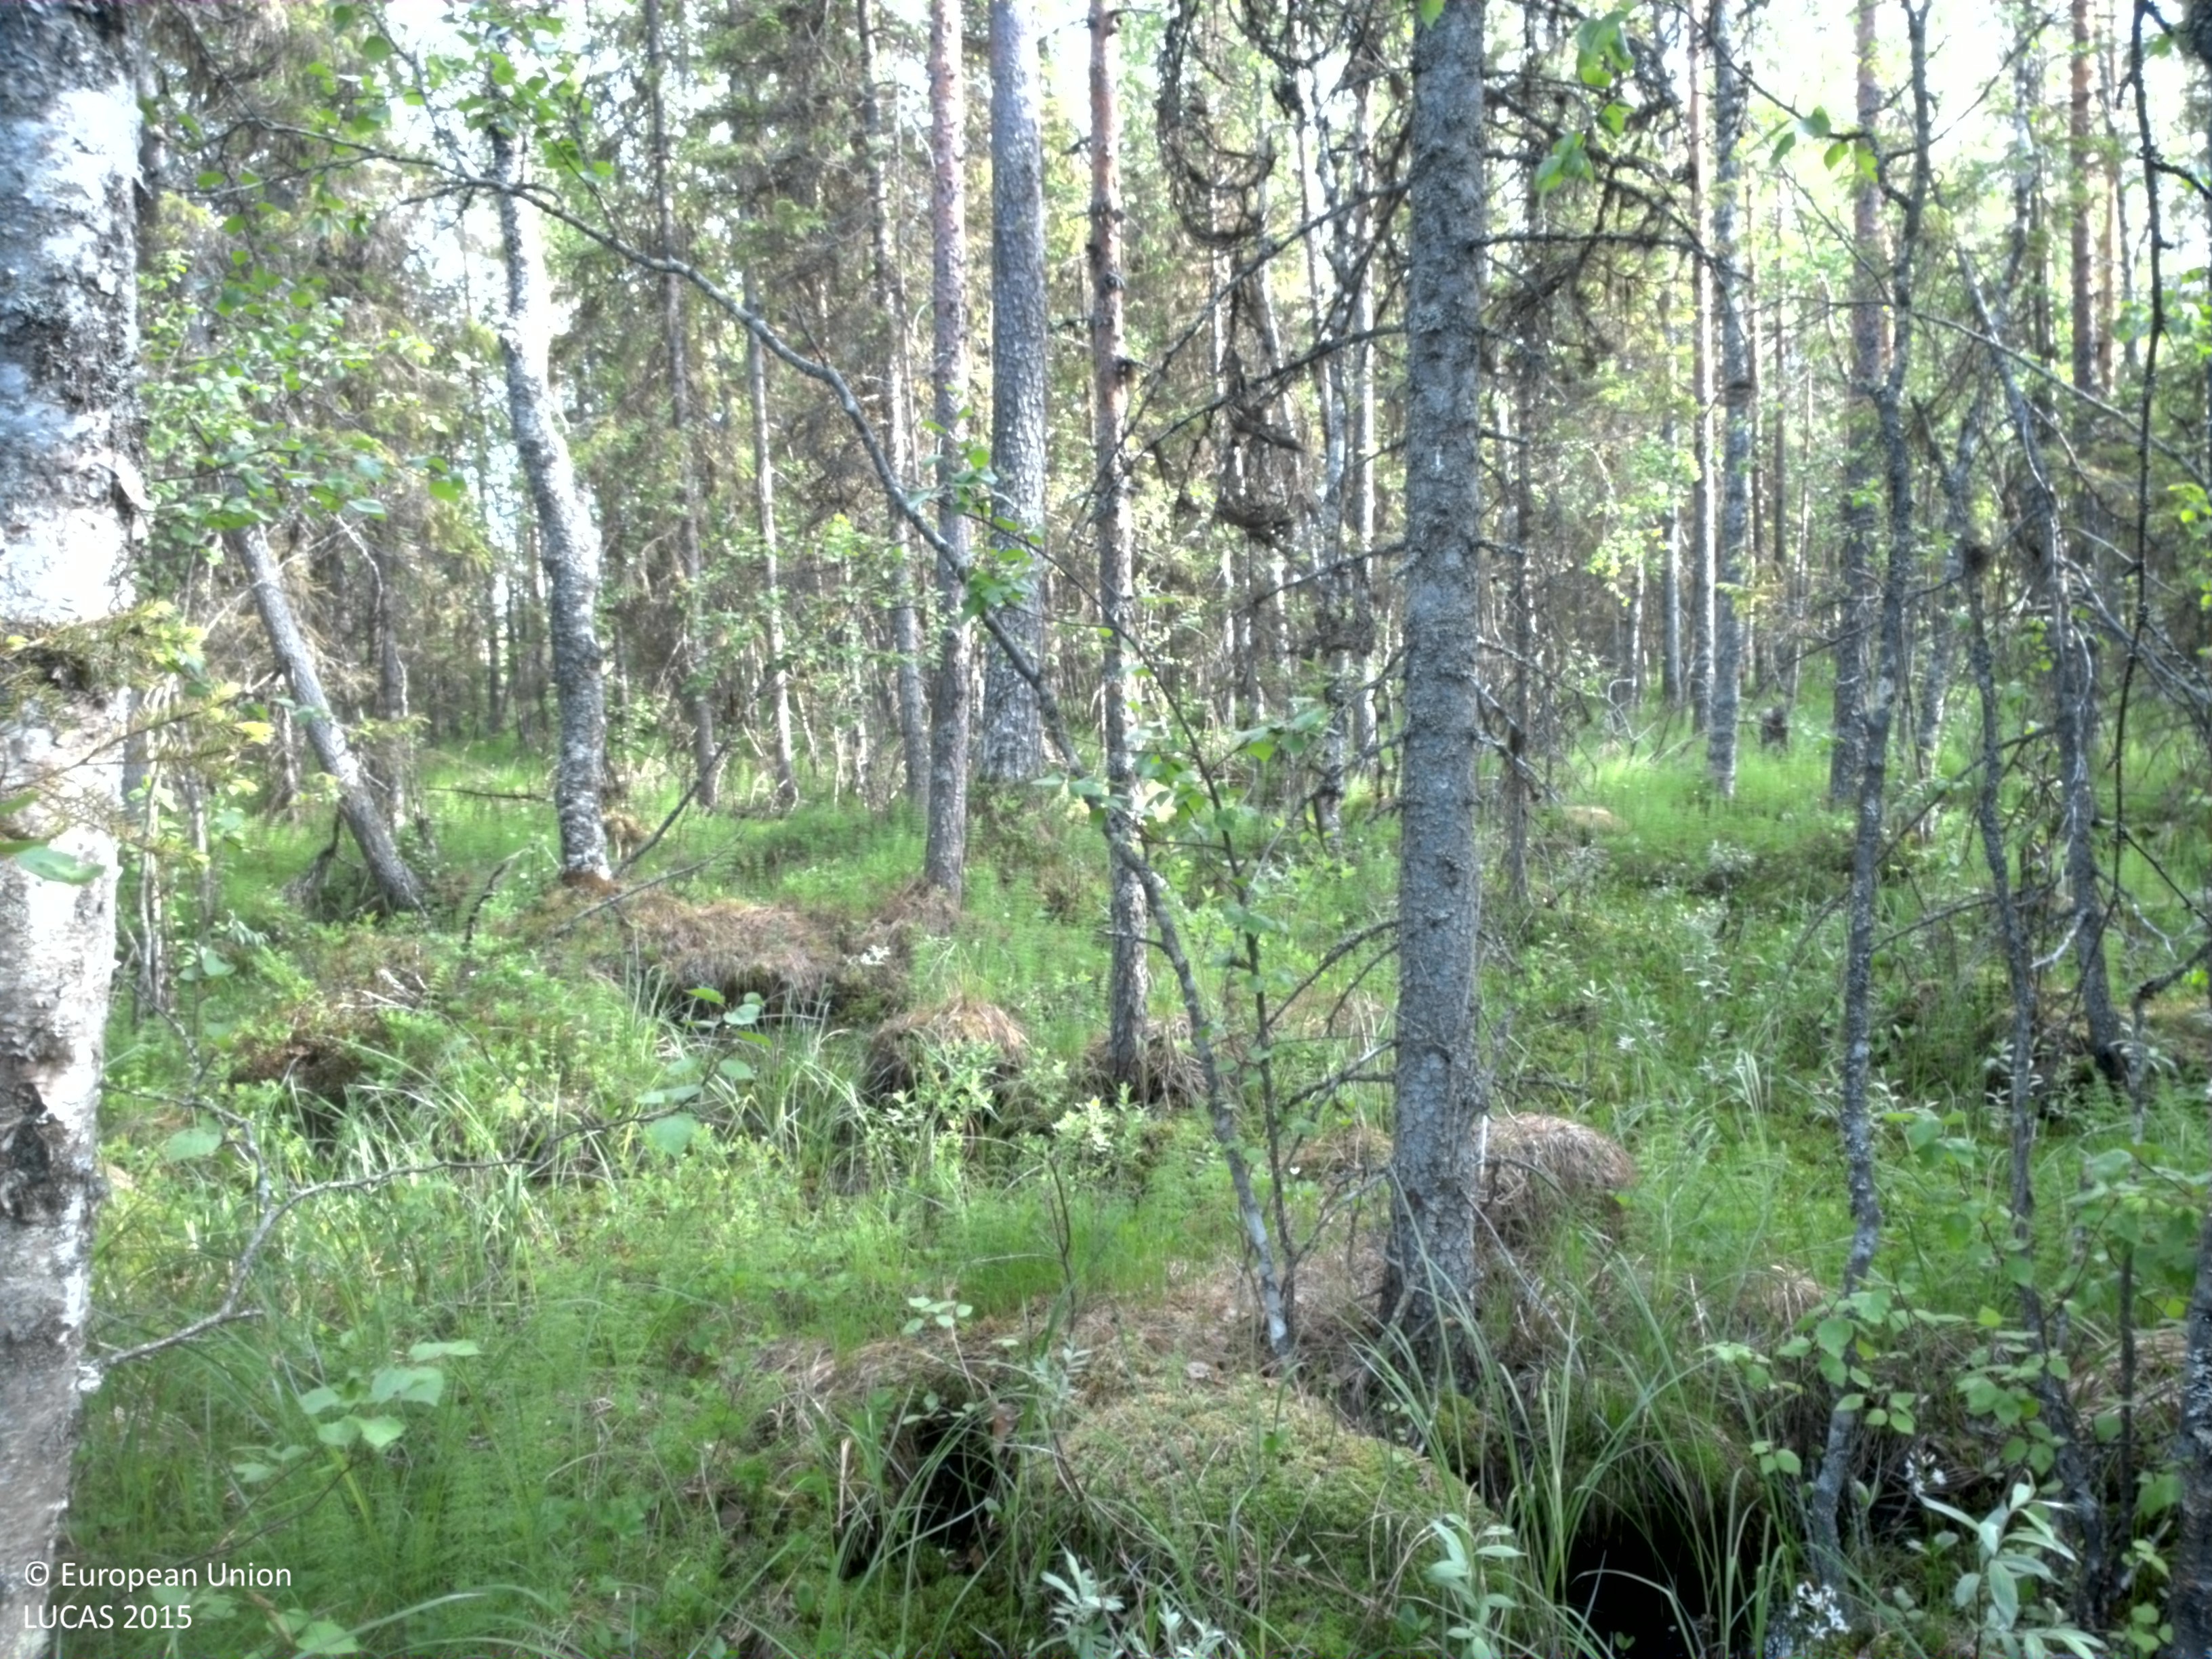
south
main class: Woodland
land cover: Pine dominated mixed woodland
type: mire and swamp forests
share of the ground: 50 - 75 %
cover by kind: broadleaved forest trees 30 %, coniferous forest trees 25 %, herbaceous plants 20 %, lichens and mosses 10 %, shrubs 5 %
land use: Semi-natural and natural areas not in use
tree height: > 5 m
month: June
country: SE
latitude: 66.2488
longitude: 22.7719
